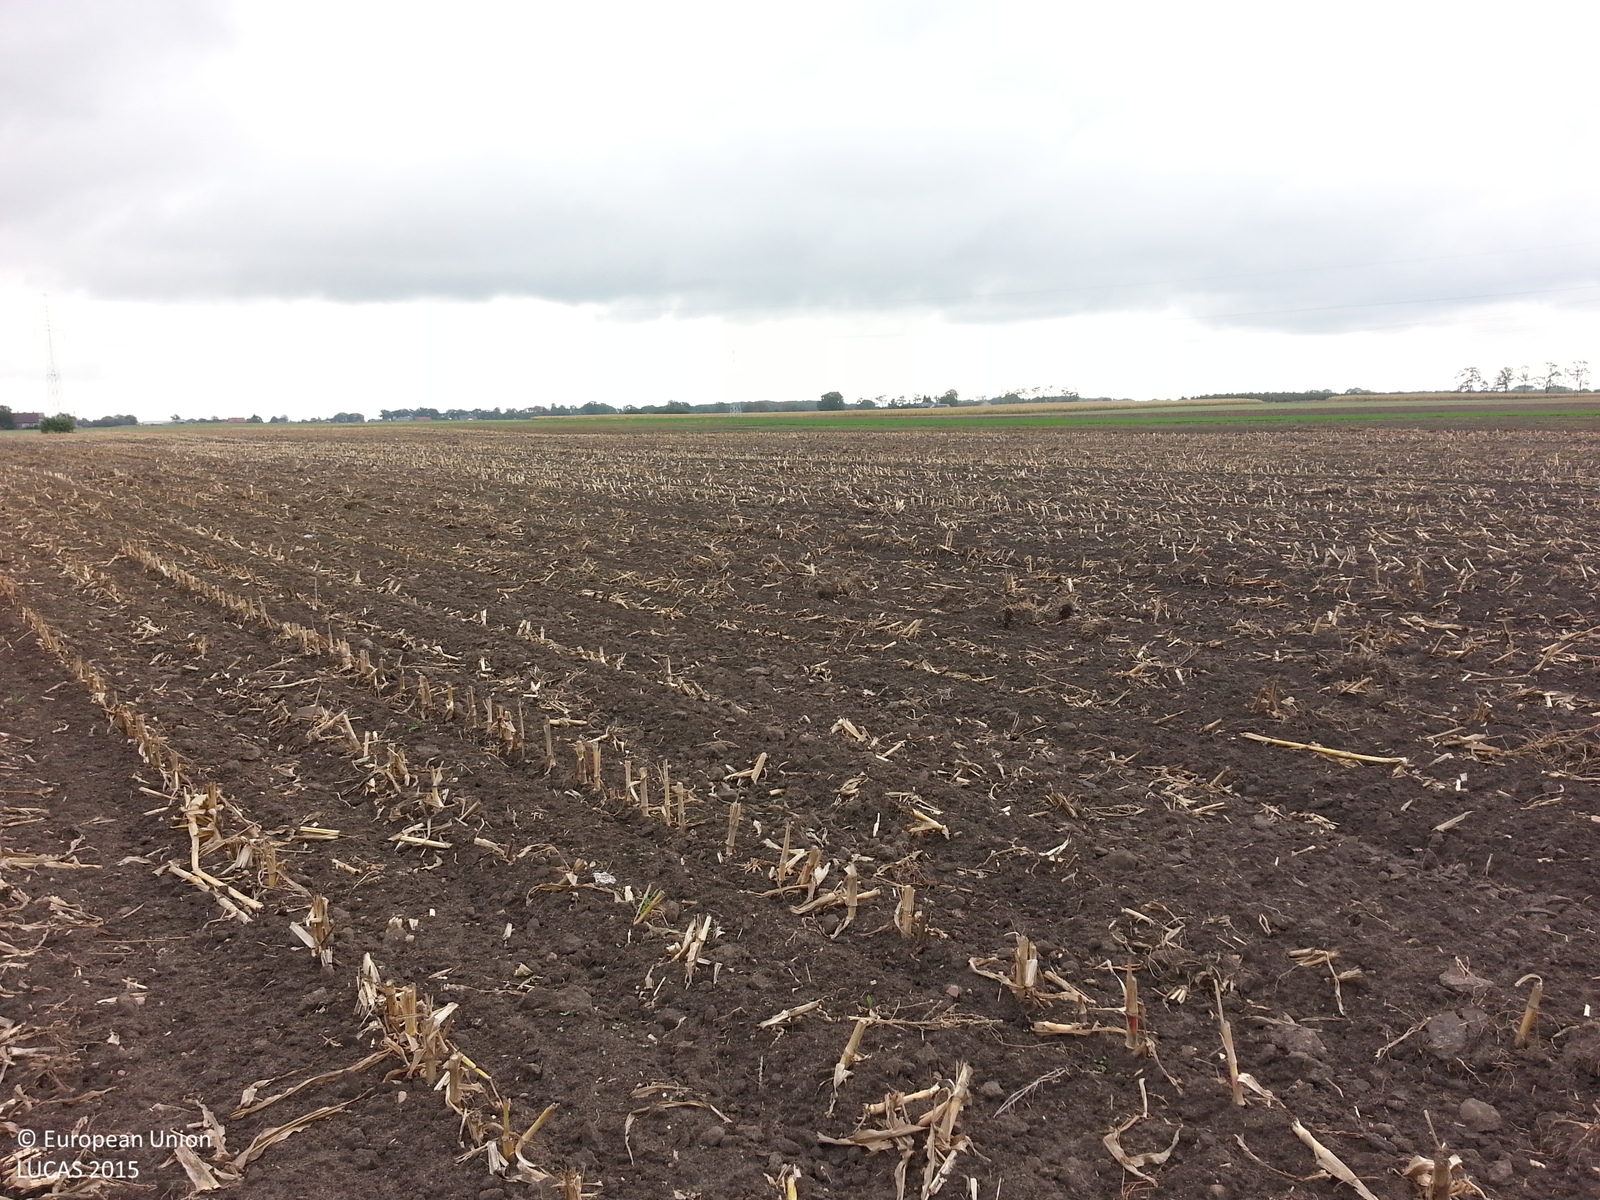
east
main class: Cropland
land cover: Maize
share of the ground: 10 - 25 %
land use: Agriculture (excluding fallow land and kitchen gardens)
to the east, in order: Maize; Common wheat; Electric lines; Common wheat; Clovers; Common wheat
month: September
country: PL
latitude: 53.2175
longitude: 18.1480
